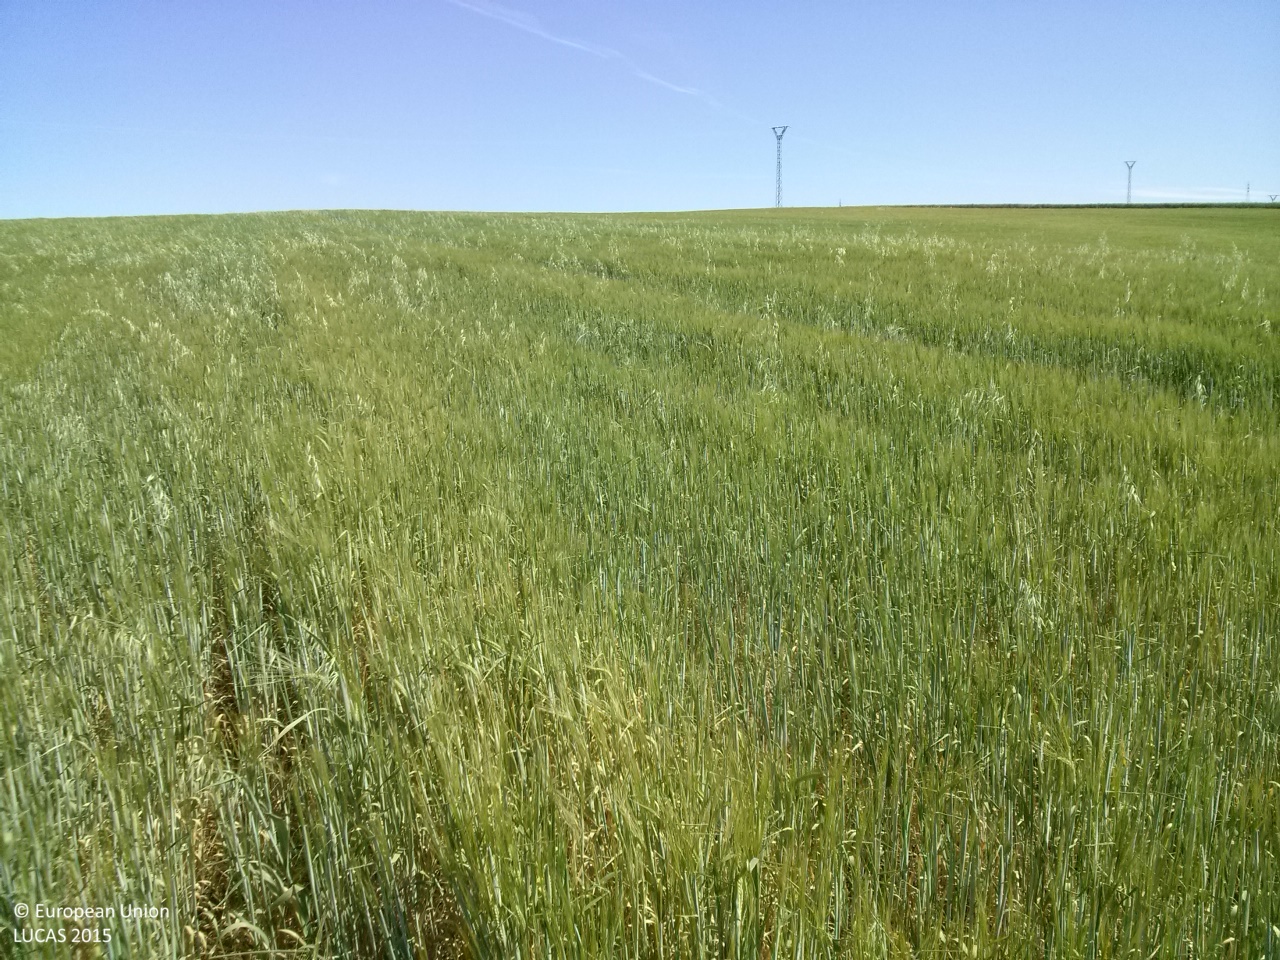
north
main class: Cropland
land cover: Barley
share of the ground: > 75 %
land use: Agriculture (excluding fallow land and kitchen gardens)
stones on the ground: < 10 %
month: May
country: ES
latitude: 39.9924
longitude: -2.7991
